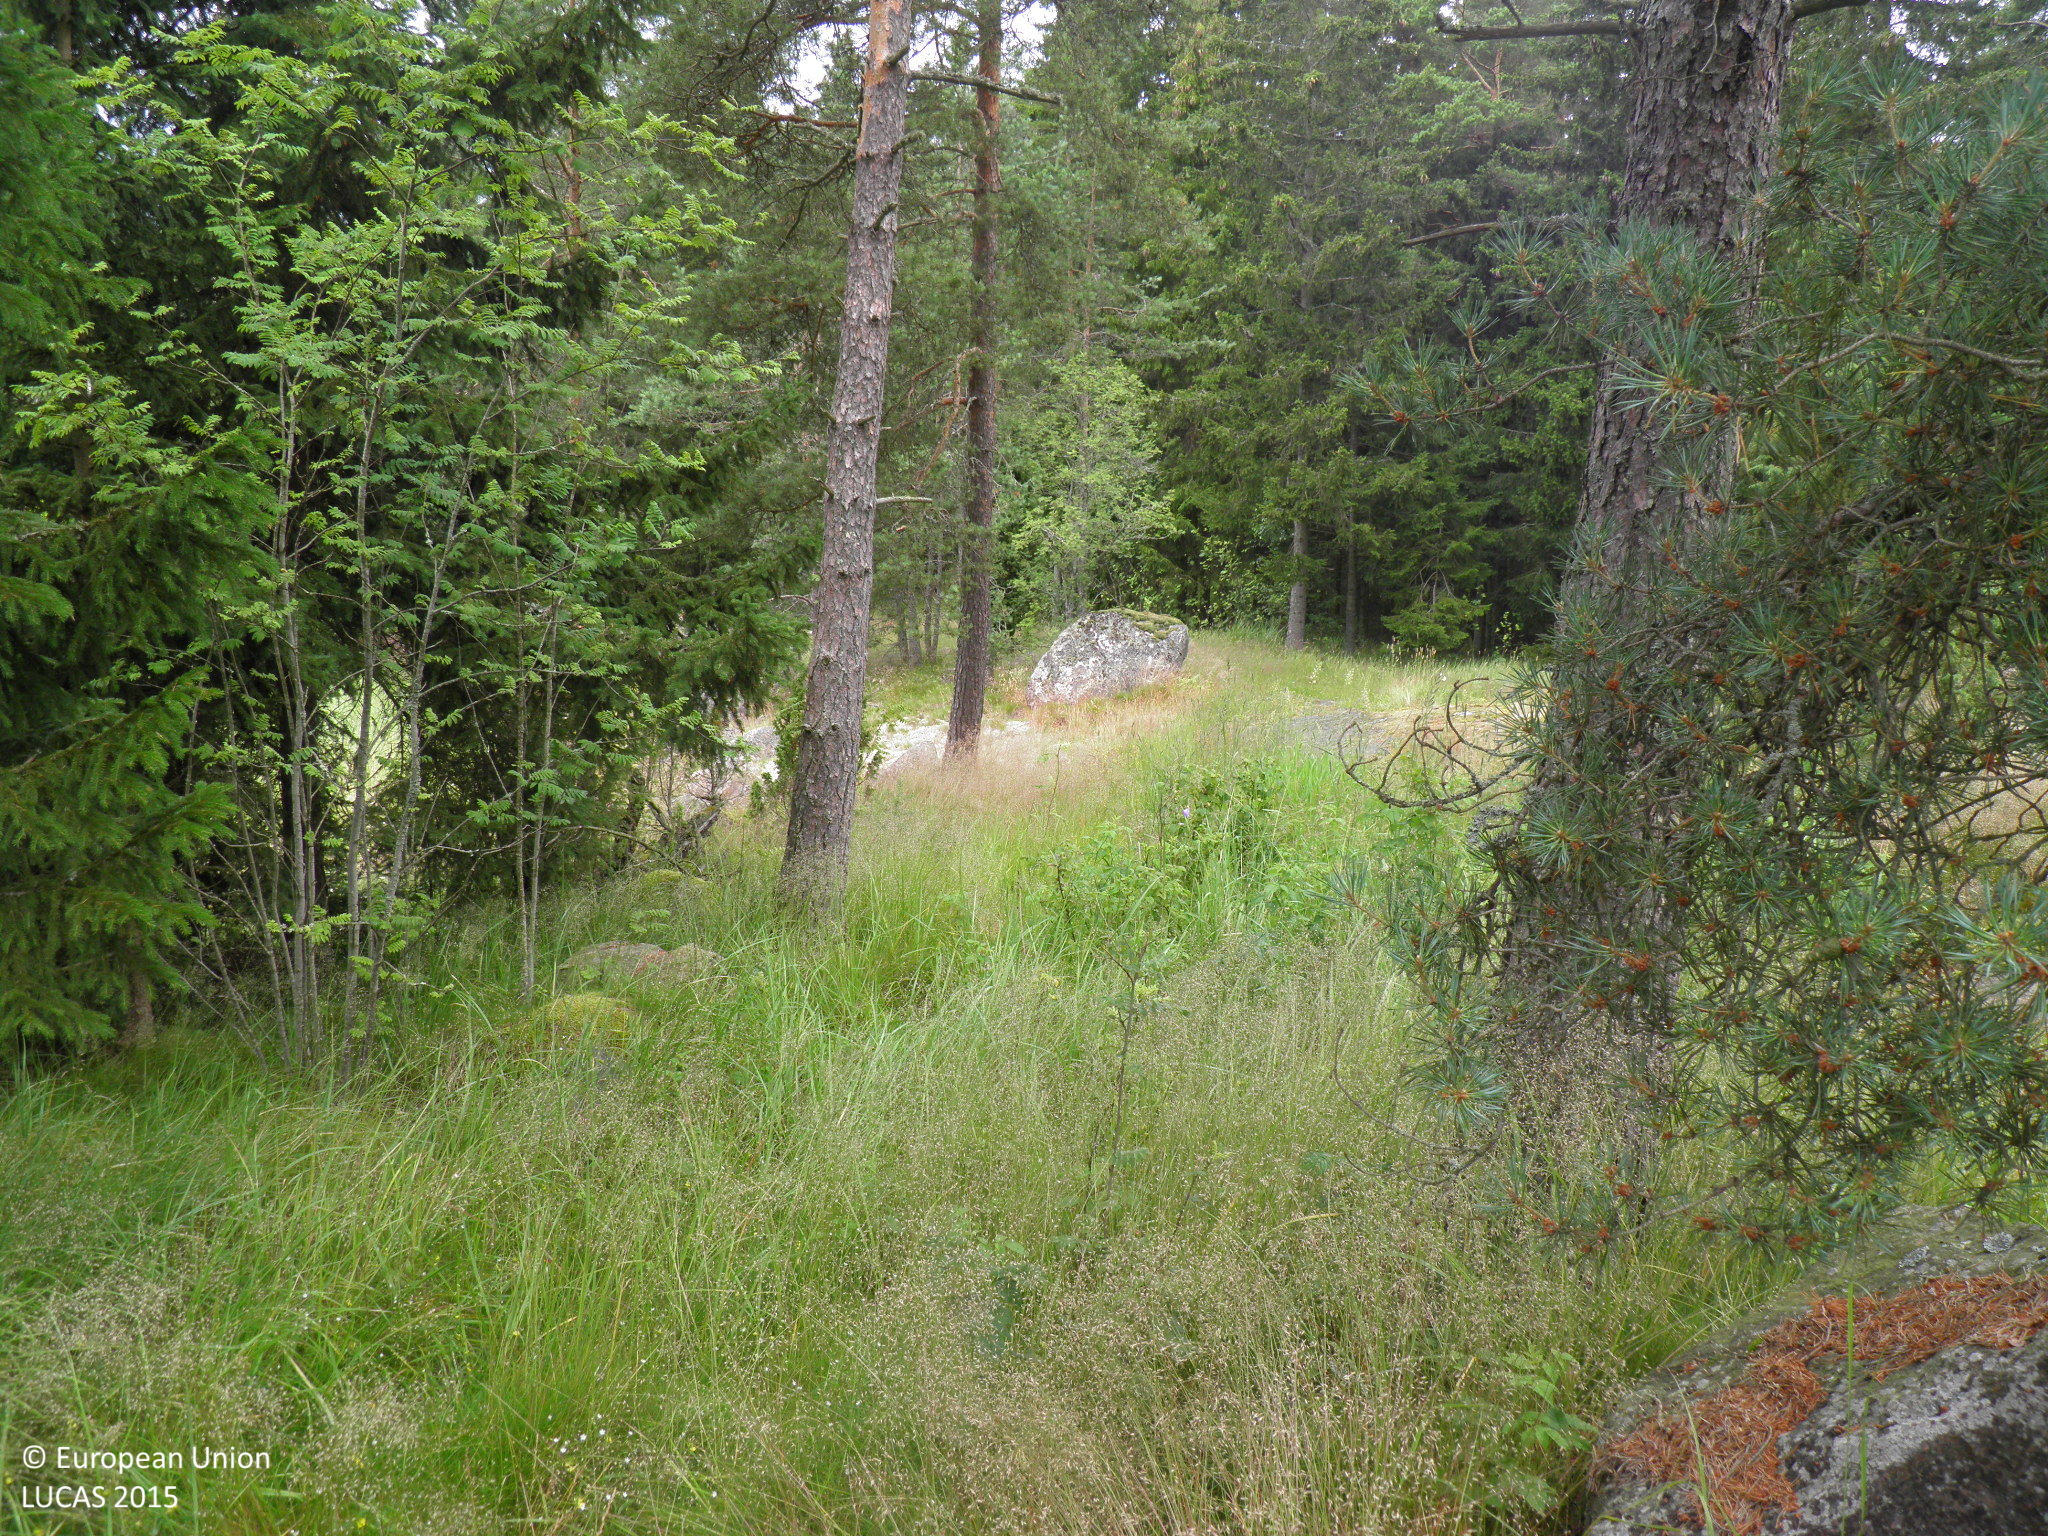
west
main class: Woodland
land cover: Pine dominated coniferous woodland
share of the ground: 10 - 25 %
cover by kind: herbaceous plants 30 %, lichens and mosses 30 %, coniferous forest trees 20 %, shrubs 10 %, consolidated bare surface 10 %
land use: Semi-natural and natural areas not in use
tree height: > 5 m
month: July
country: FI
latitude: 60.6572
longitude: 21.7117
